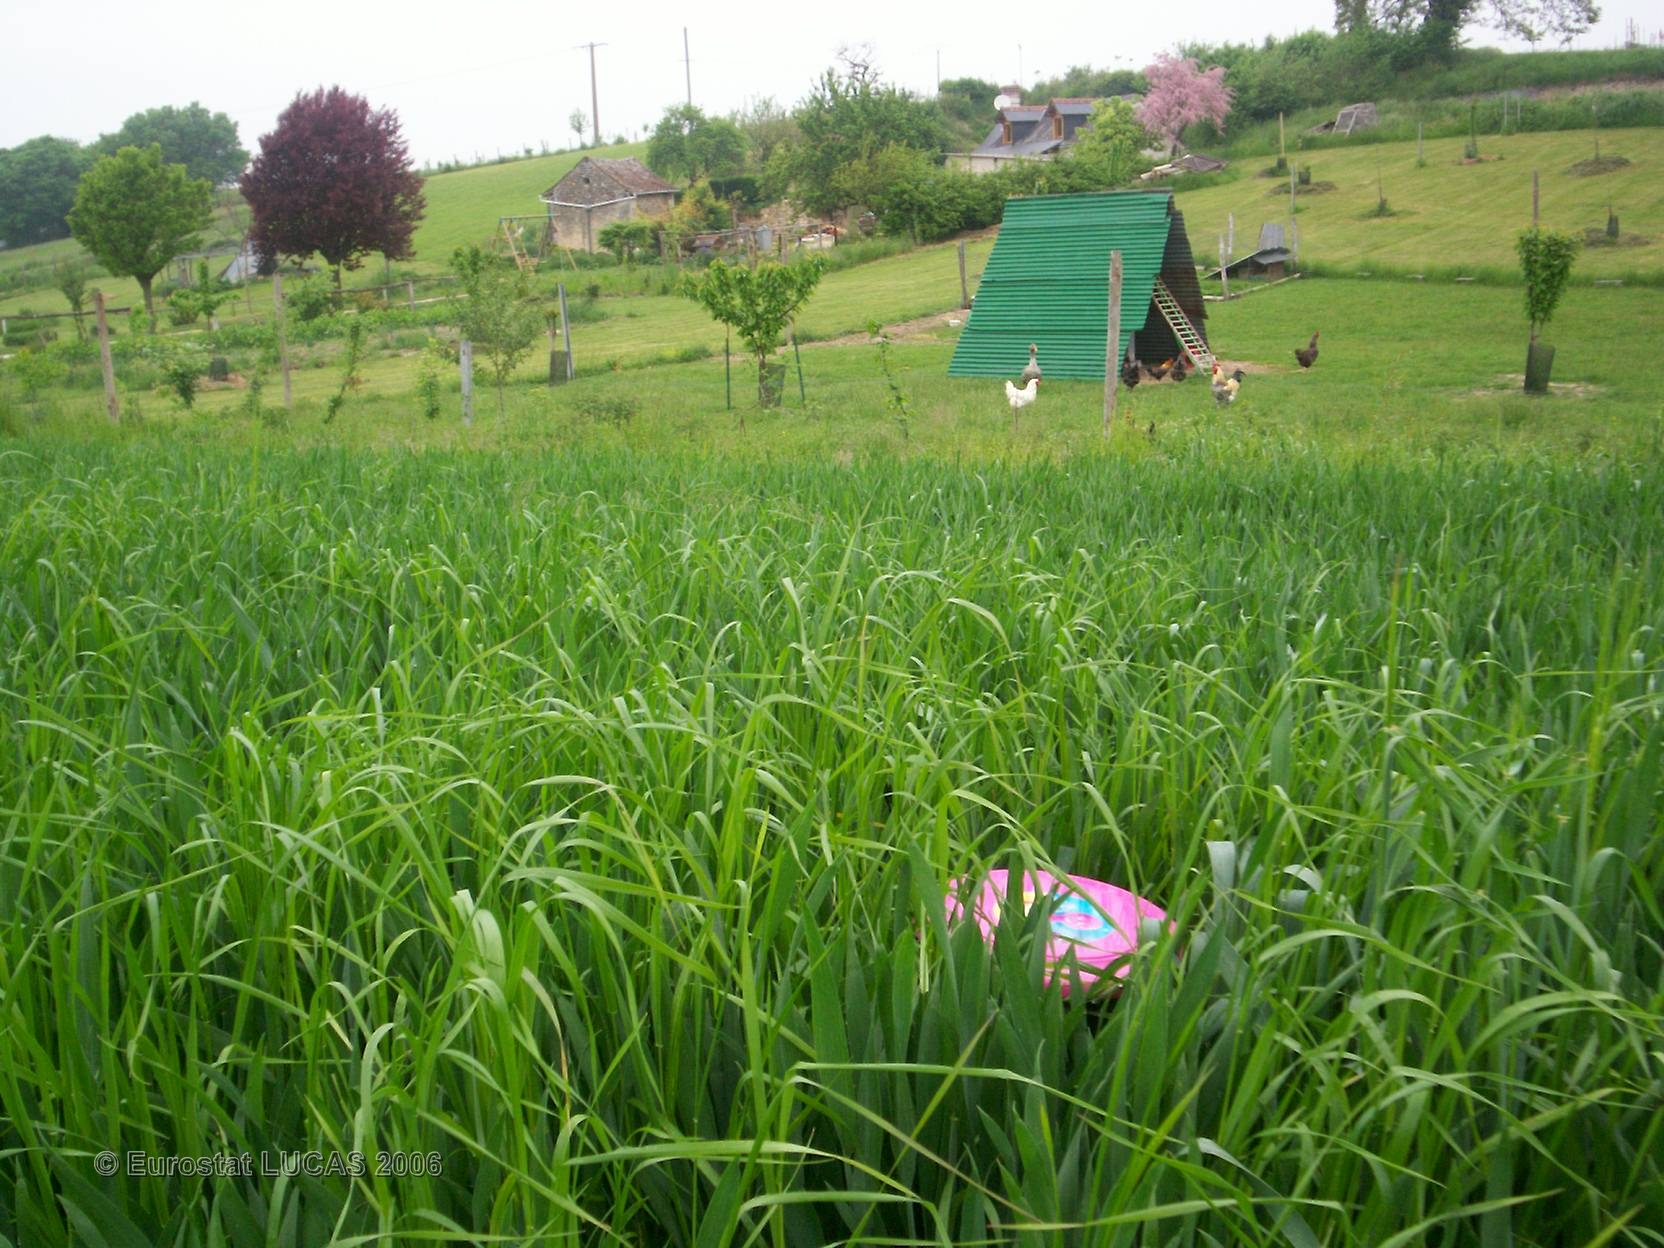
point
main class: Cropland
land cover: Common wheat
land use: Agriculture (excluding fallow land and kitchen gardens)
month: May
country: FR
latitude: 47.6482
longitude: 0.4860
